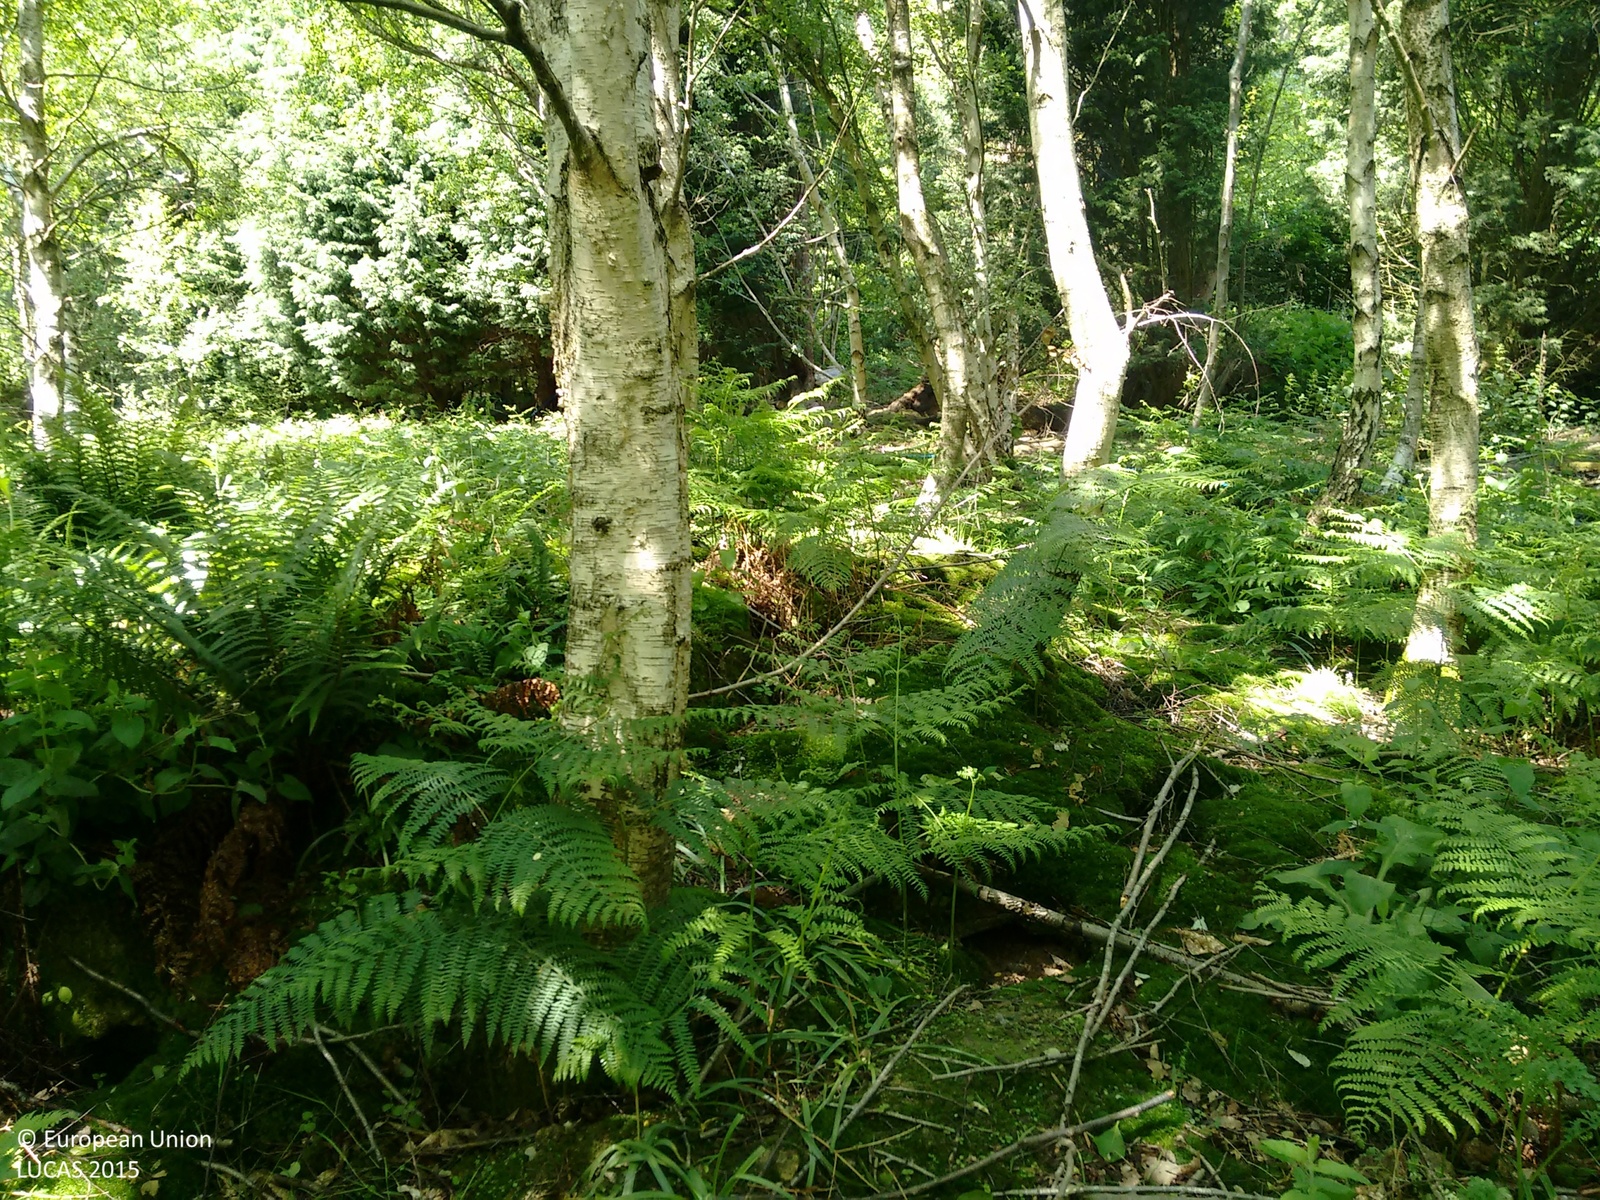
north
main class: Woodland
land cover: Broadleaved woodland
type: mesophytic deciduous forest
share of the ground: > 75 %
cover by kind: broadleaved forest trees 75 %, coniferous forest trees 15 %, shrubs 5 %, herbaceous plants 5 %
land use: Forestry
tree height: > 5 m
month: June
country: GB
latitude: 51.0445
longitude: 0.6021
